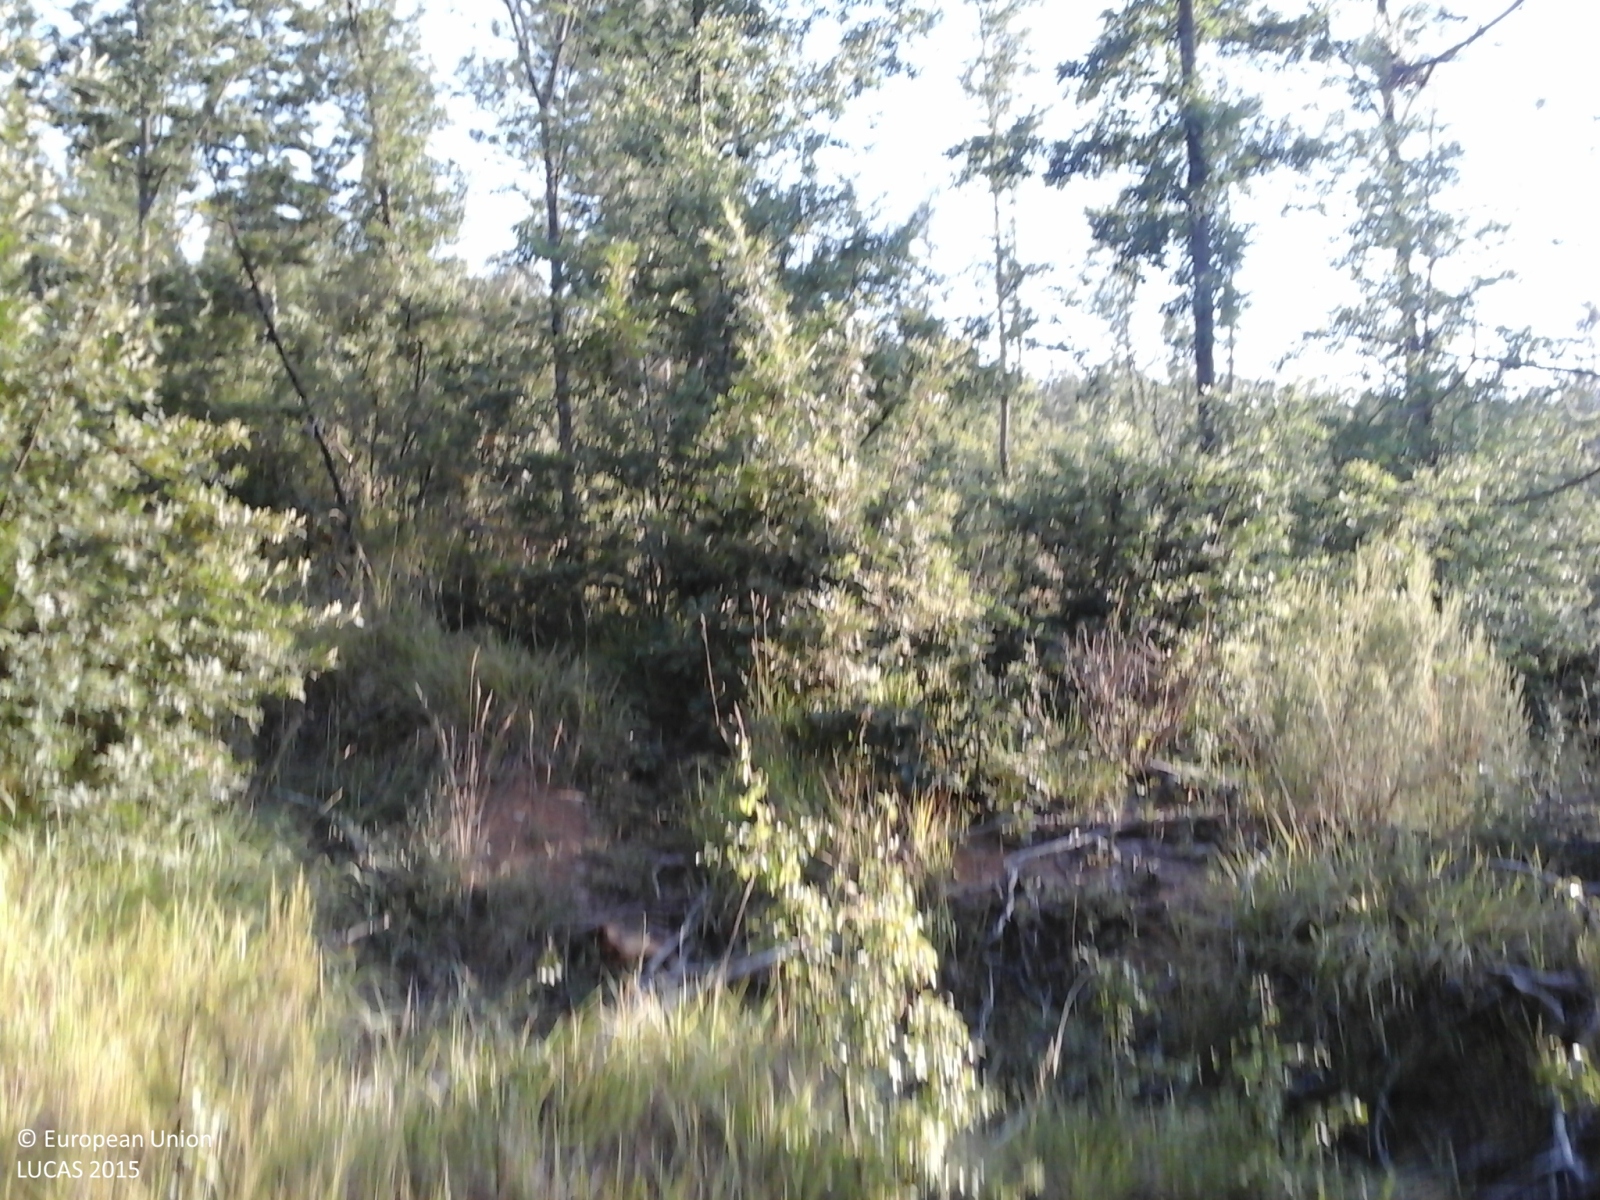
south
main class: Woodland
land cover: Pine dominated mixed woodland
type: coniferous forest of the mediterranean region
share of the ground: > 75 %
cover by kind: coniferous forest trees 45 %, broadleaved forest trees 25 %, shrubs 20 %, herbaceous plants 10 %
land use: Forestry
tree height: > 5 m
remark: Clear cut
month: August
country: IT
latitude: 42.7856
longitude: 11.6206
